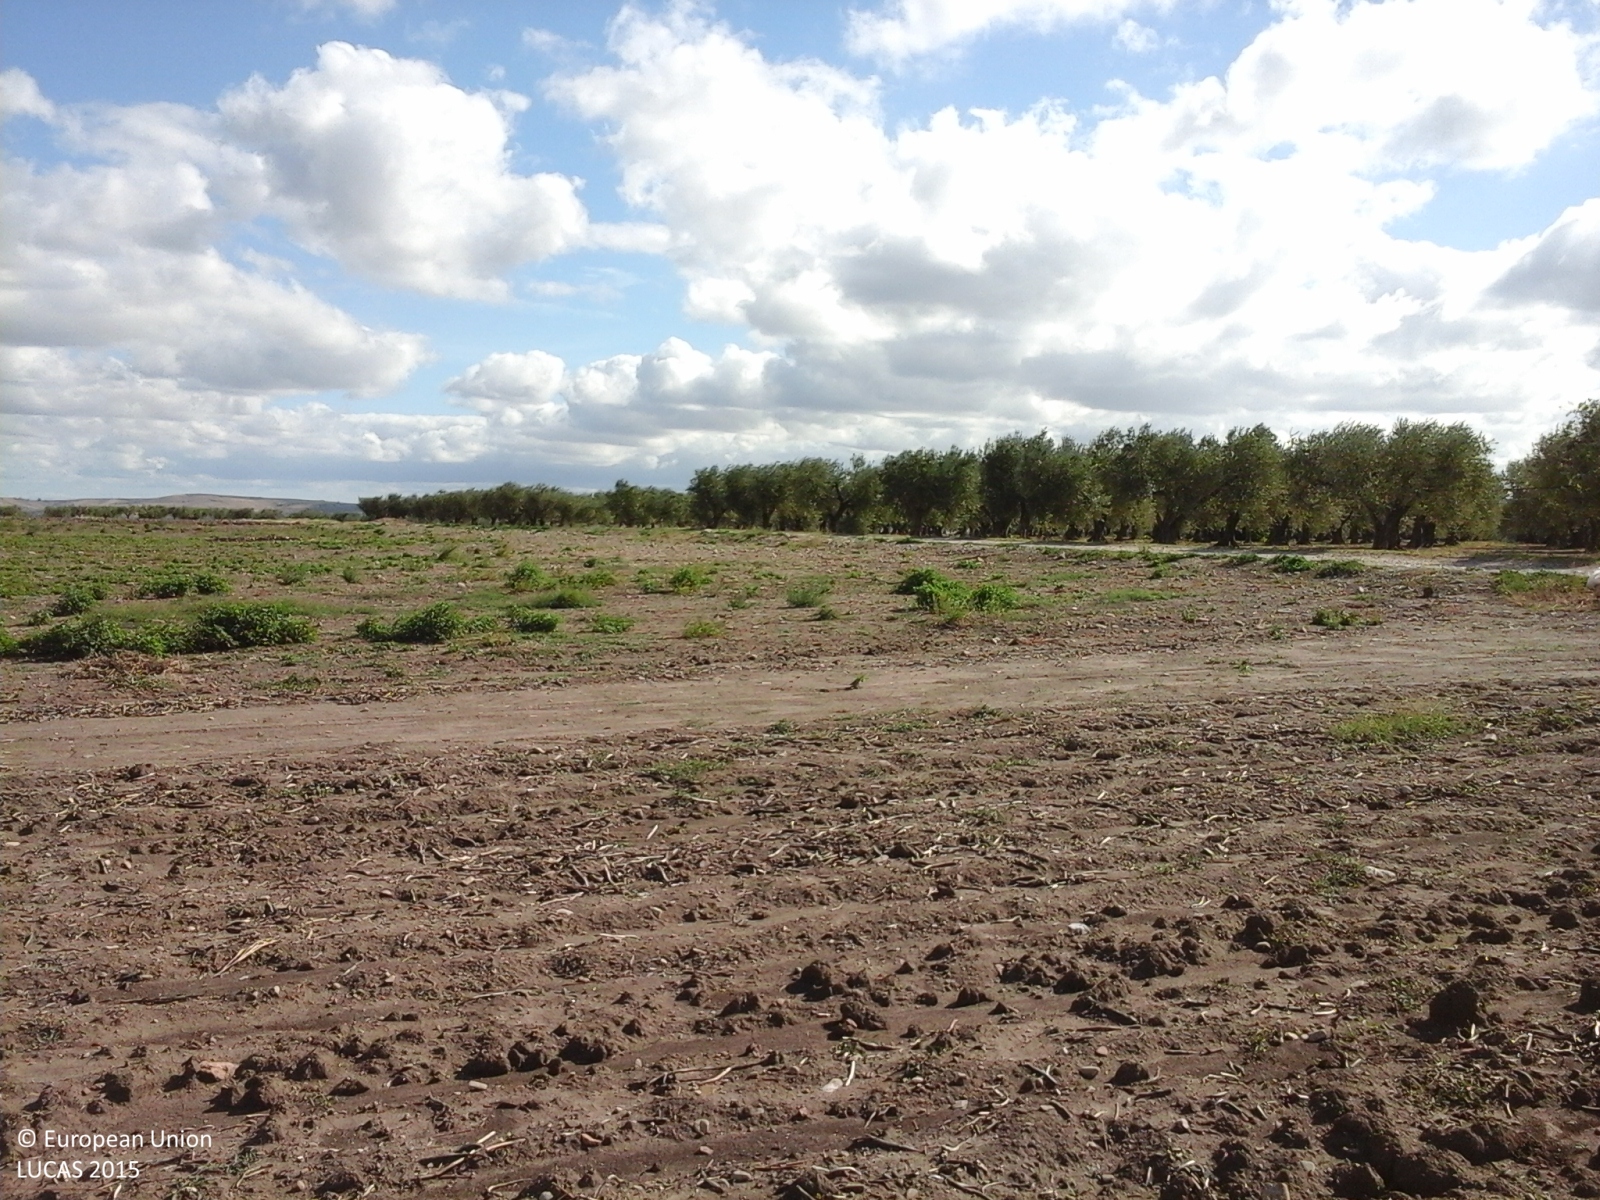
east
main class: Cropland
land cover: Dry pulses
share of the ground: > 75 %
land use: Agriculture (excluding fallow land and kitchen gardens)
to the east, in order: Dry pulses; Tomatoes; Grass margins; Paved roads, cycling and walking lanes; Grass margins; Olive groves
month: September
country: IT
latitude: 41.6898
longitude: 15.1617
